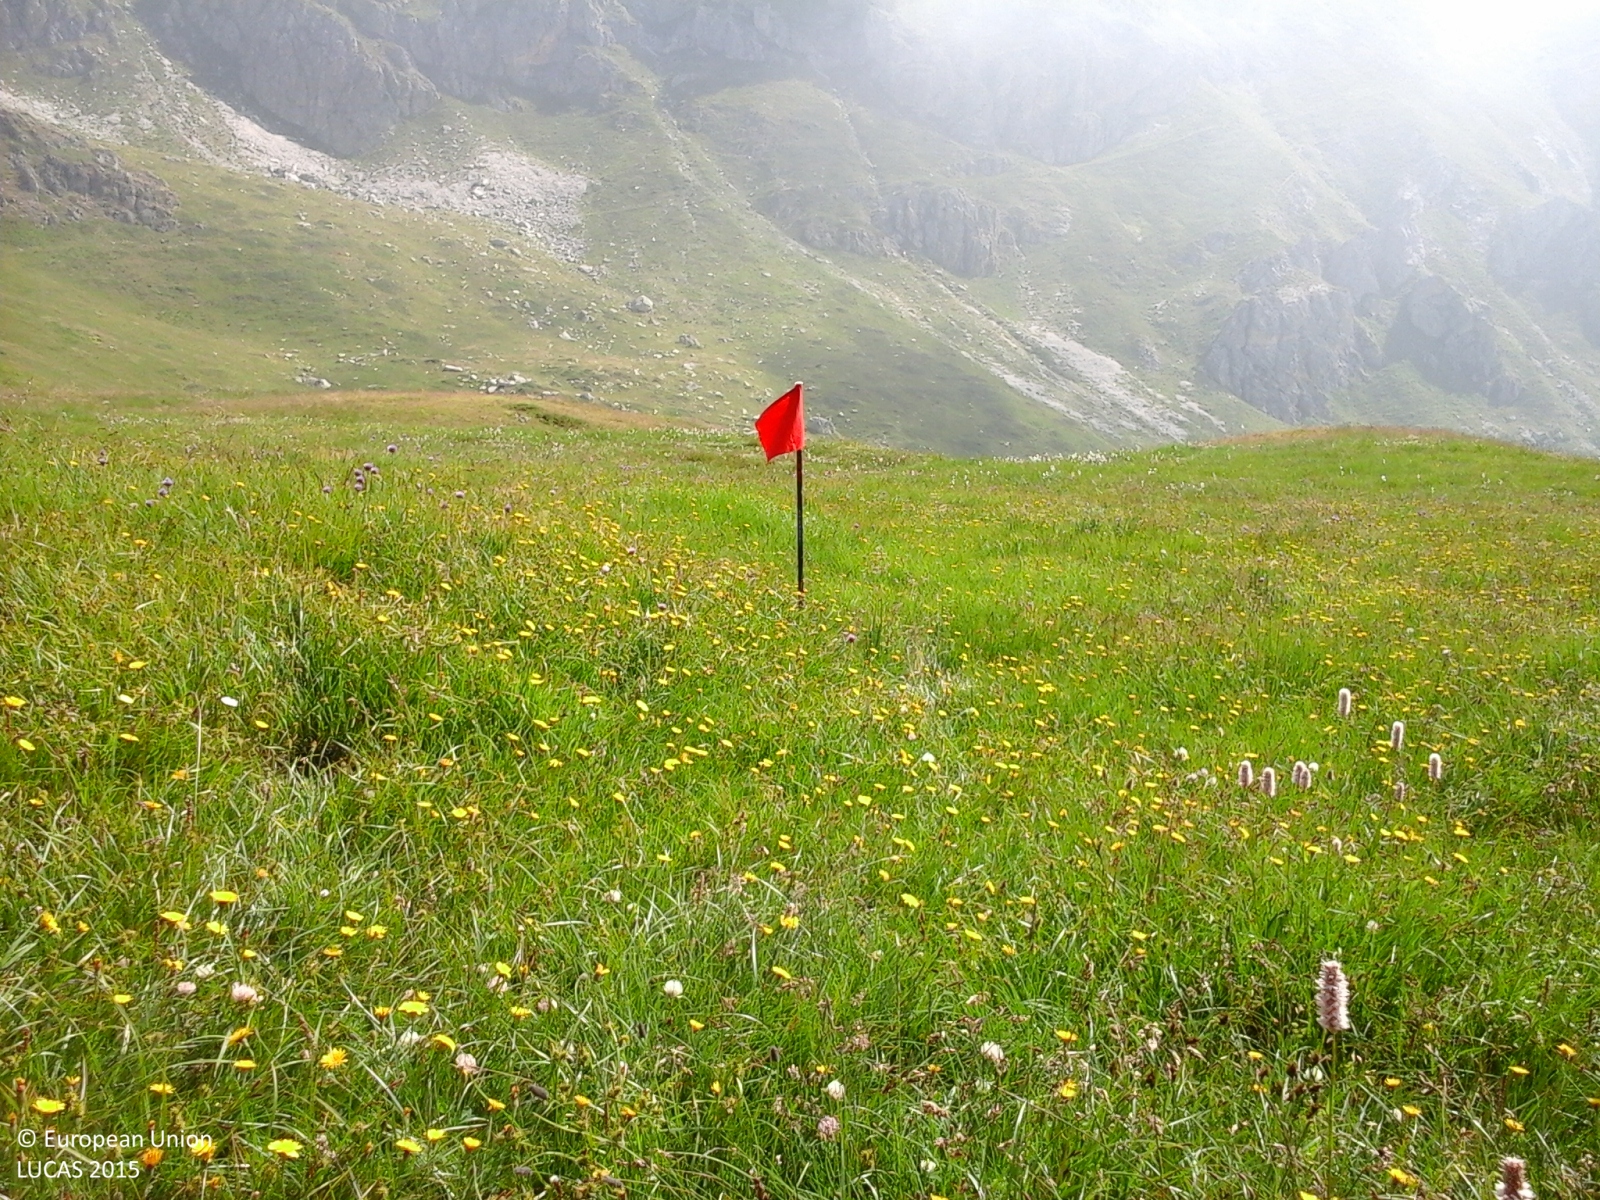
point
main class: Grassland
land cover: Grassland without tree/shrub cover
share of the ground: > 75 %
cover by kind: herbaceous plants 100 %
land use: Agriculture (excluding fallow land and kitchen gardens)
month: July
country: IT
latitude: 44.4011
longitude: 7.1305
